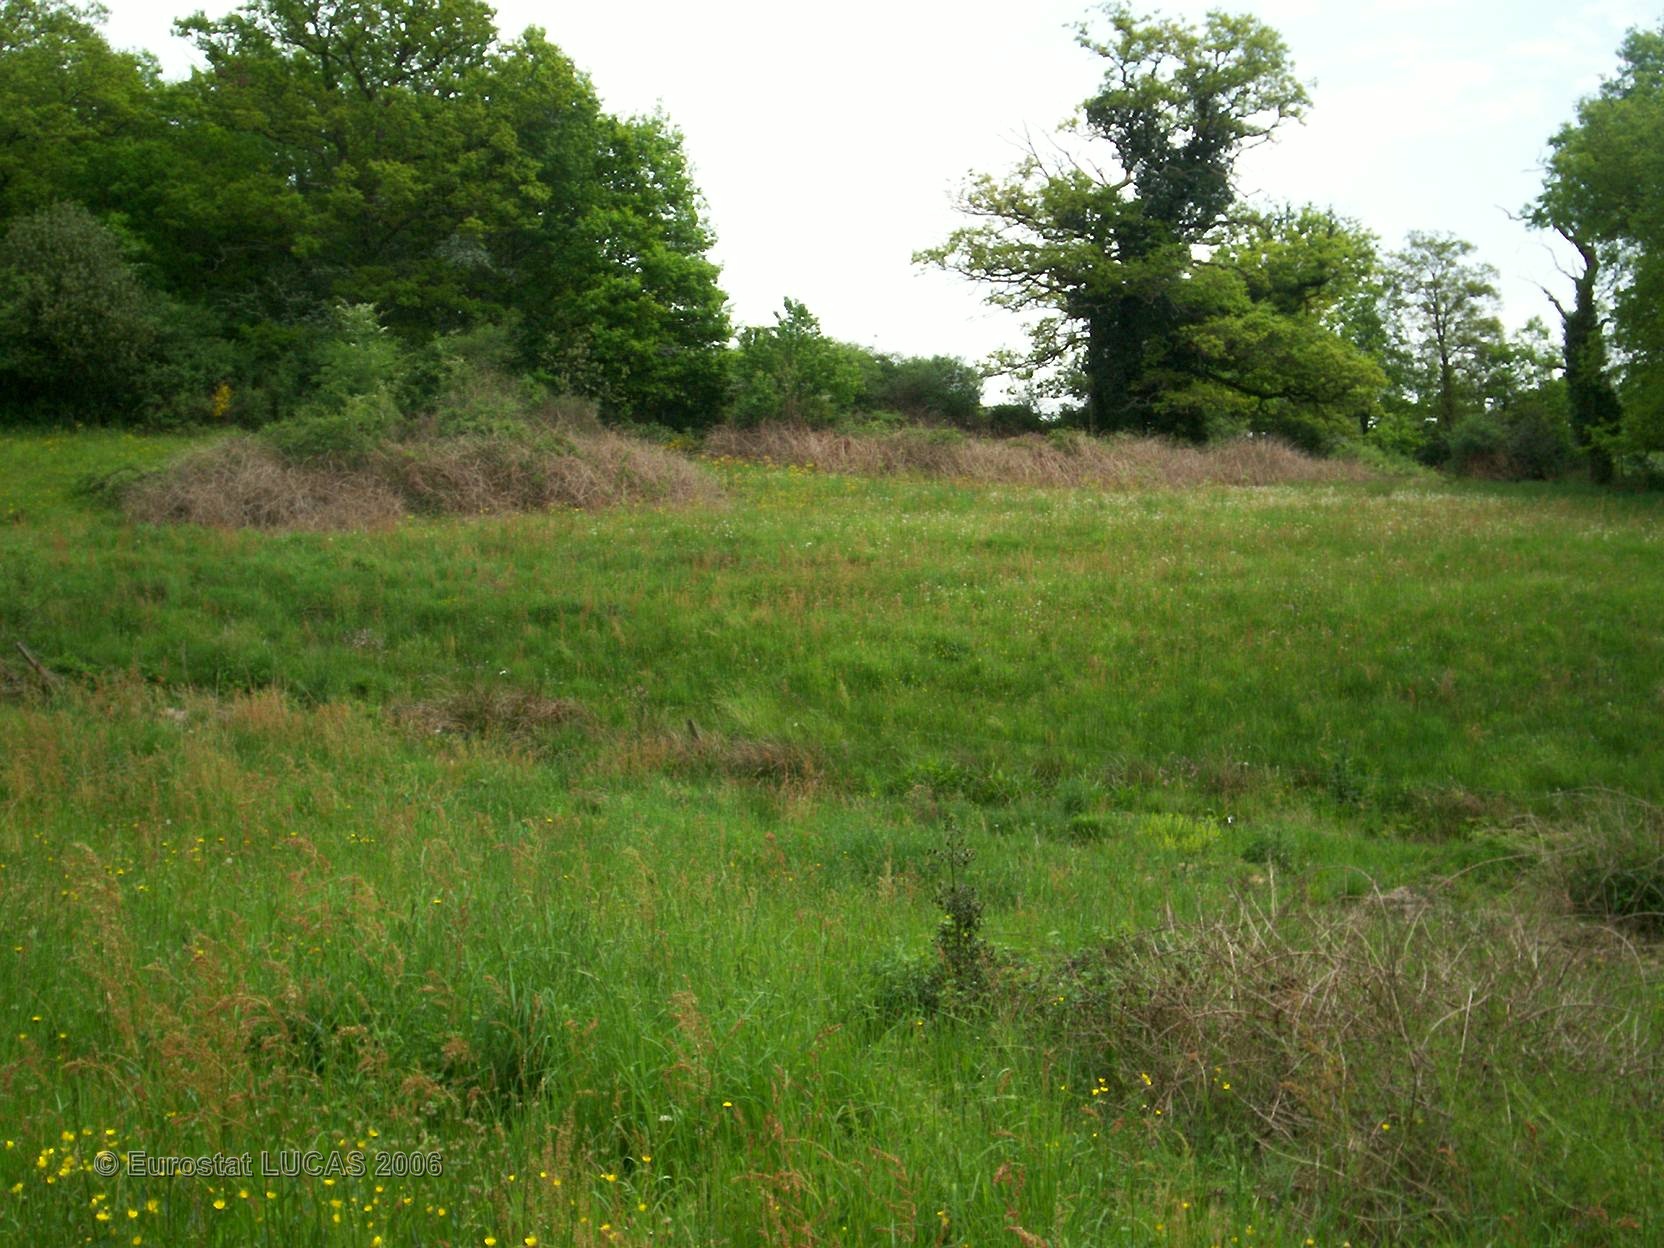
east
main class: Grassland
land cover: Grassland without tree/shrub cover
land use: Agriculture (excluding fallow land and kitchen gardens)
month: May
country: FR
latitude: 46.1202
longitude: 1.4892
